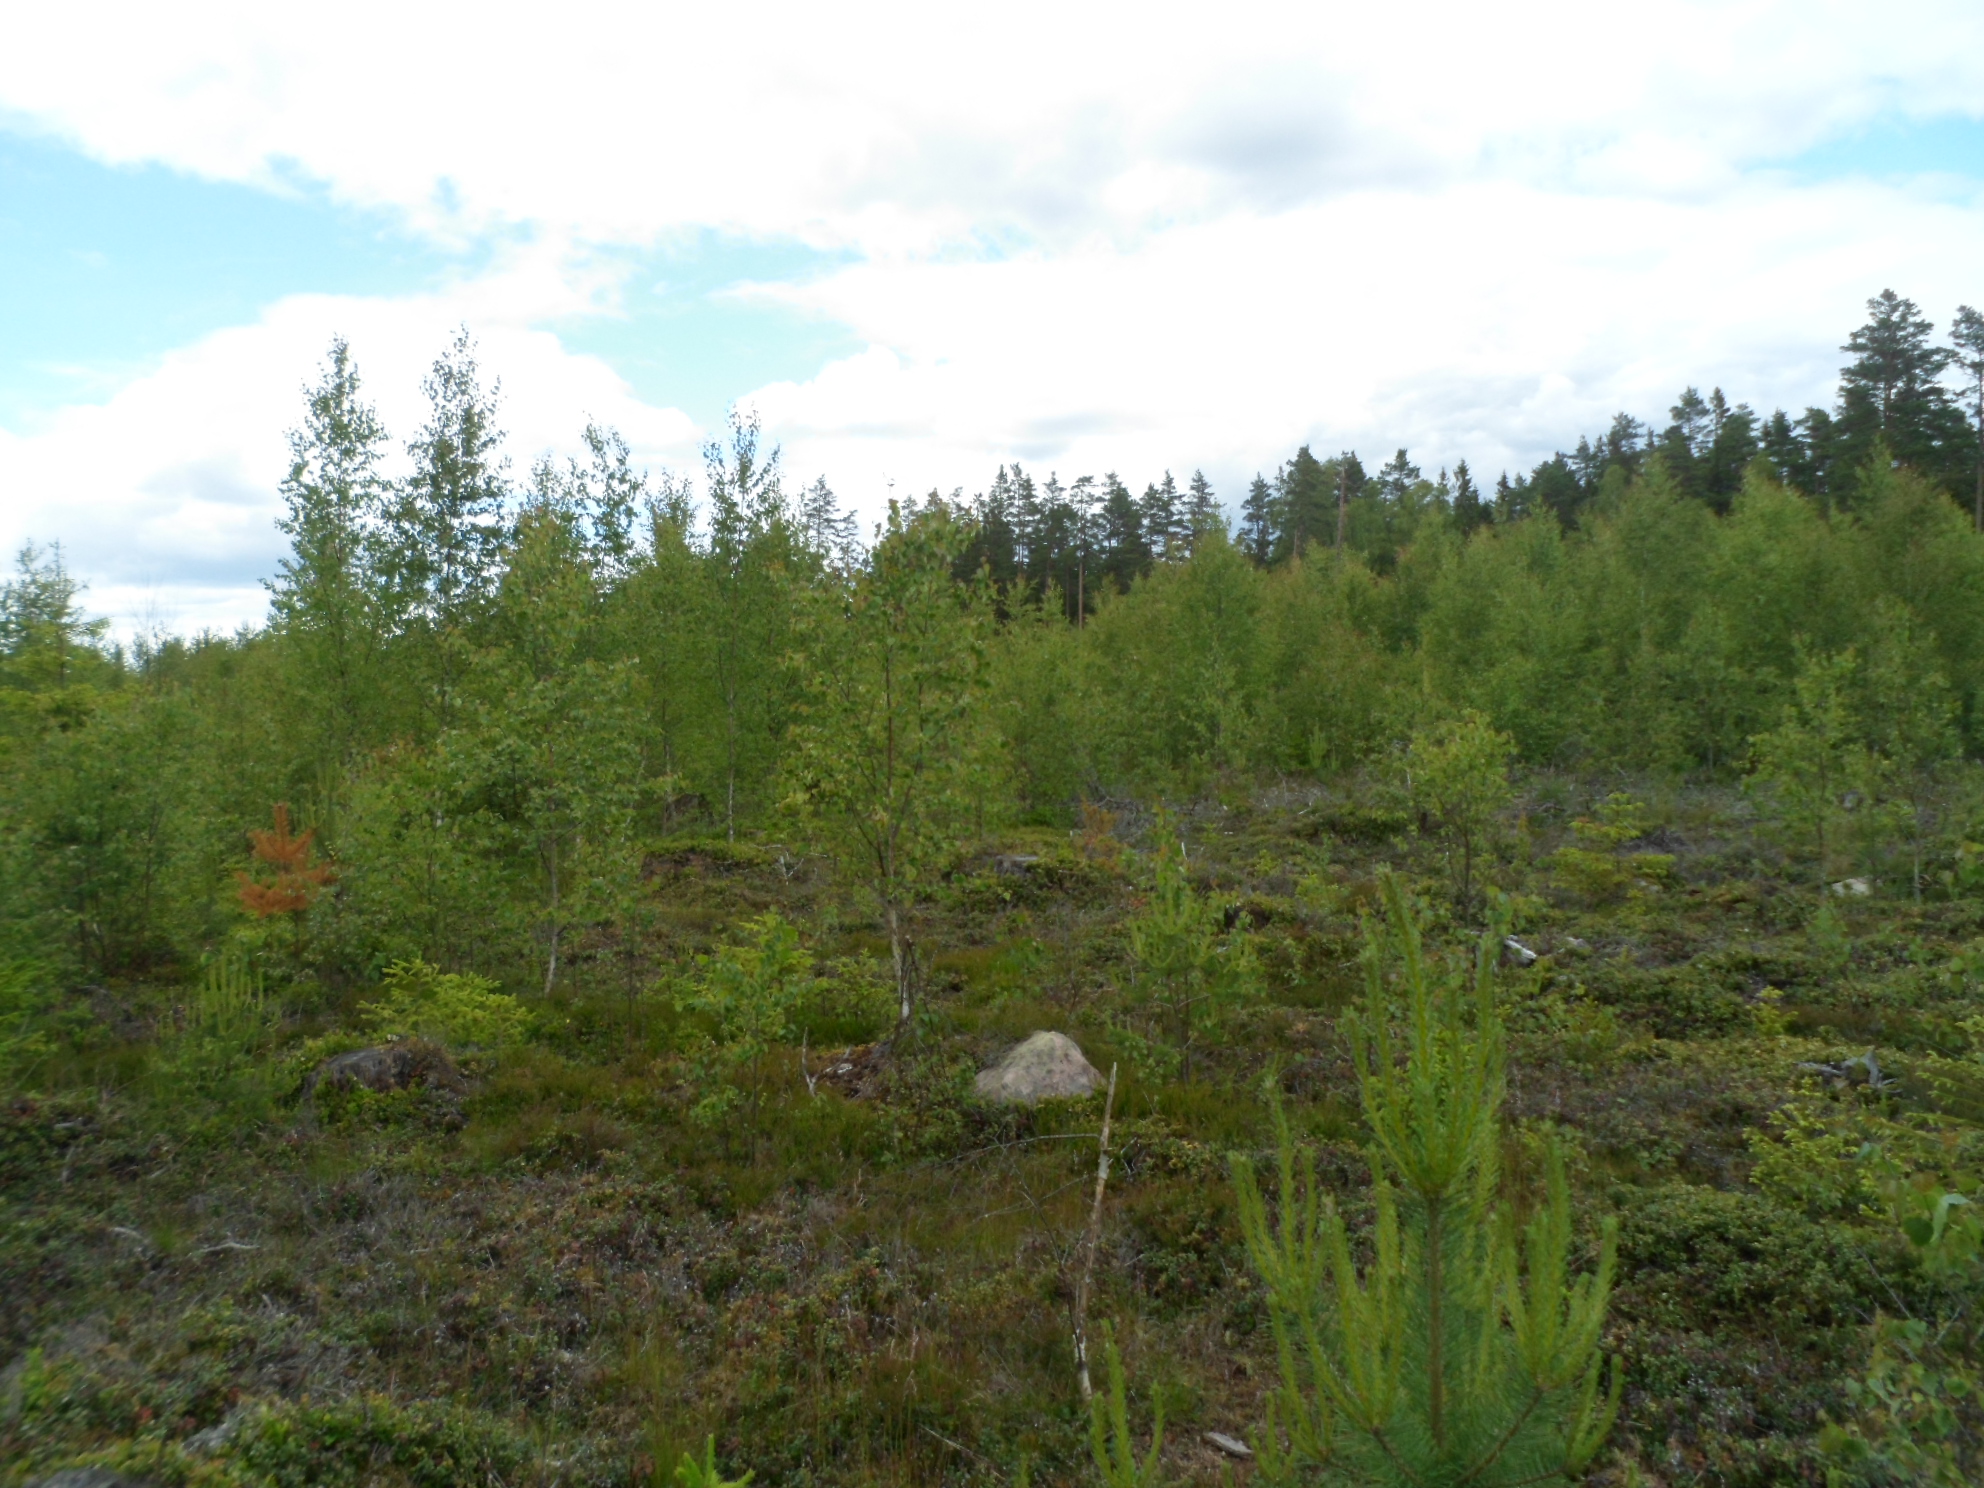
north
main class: Woodland
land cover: Pine dominated mixed woodland
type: boreal forest
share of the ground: 25 - 50 %
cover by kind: shrubs 40 %, coniferous forest trees 20 %, broadleaved forest trees 20 %, herbaceous plants 10 %, lichens and mosses 10 %
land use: Forestry
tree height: < 5 m
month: June
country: SE
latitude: 57.1038
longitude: 14.3711
